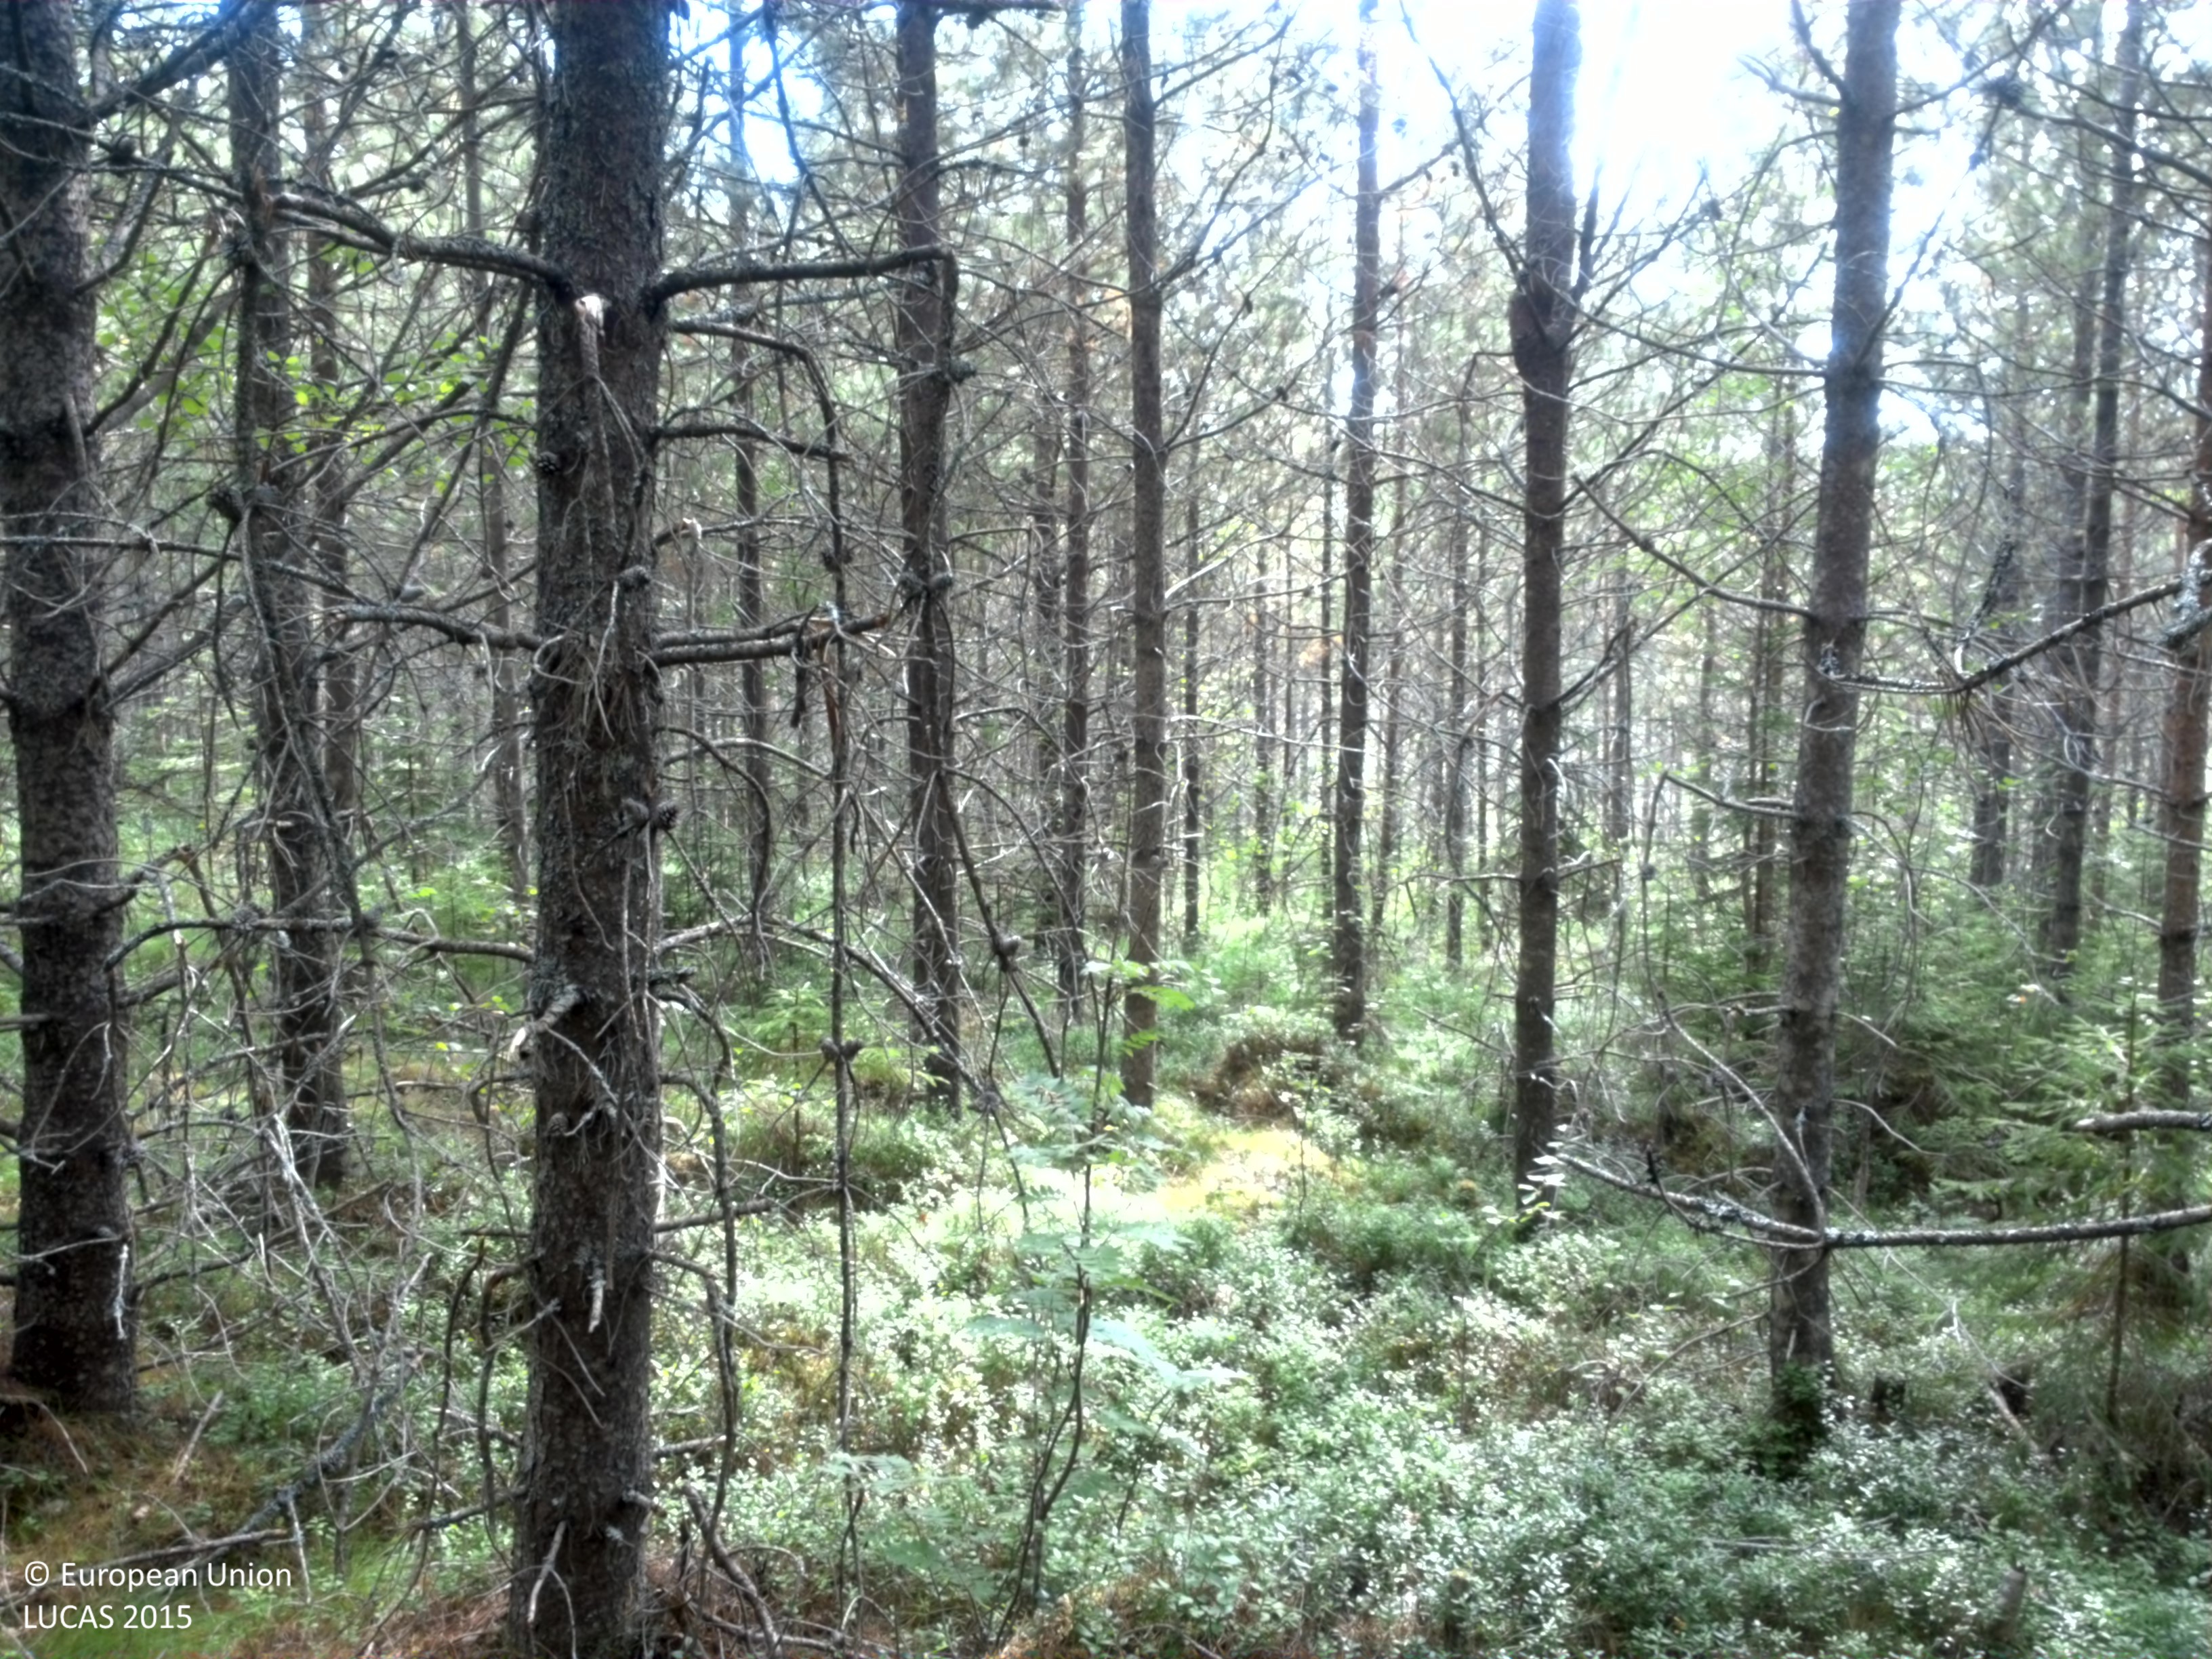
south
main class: Woodland
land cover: Pine dominated coniferous woodland
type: exotic forest
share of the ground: > 75 %
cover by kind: coniferous forest trees 75 %, shrubs 15 %, broadleaved forest trees 5 %, herbaceous plants 5 %
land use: Forestry
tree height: > 5 m
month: August
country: SE
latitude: 60.1208
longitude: 14.1107
